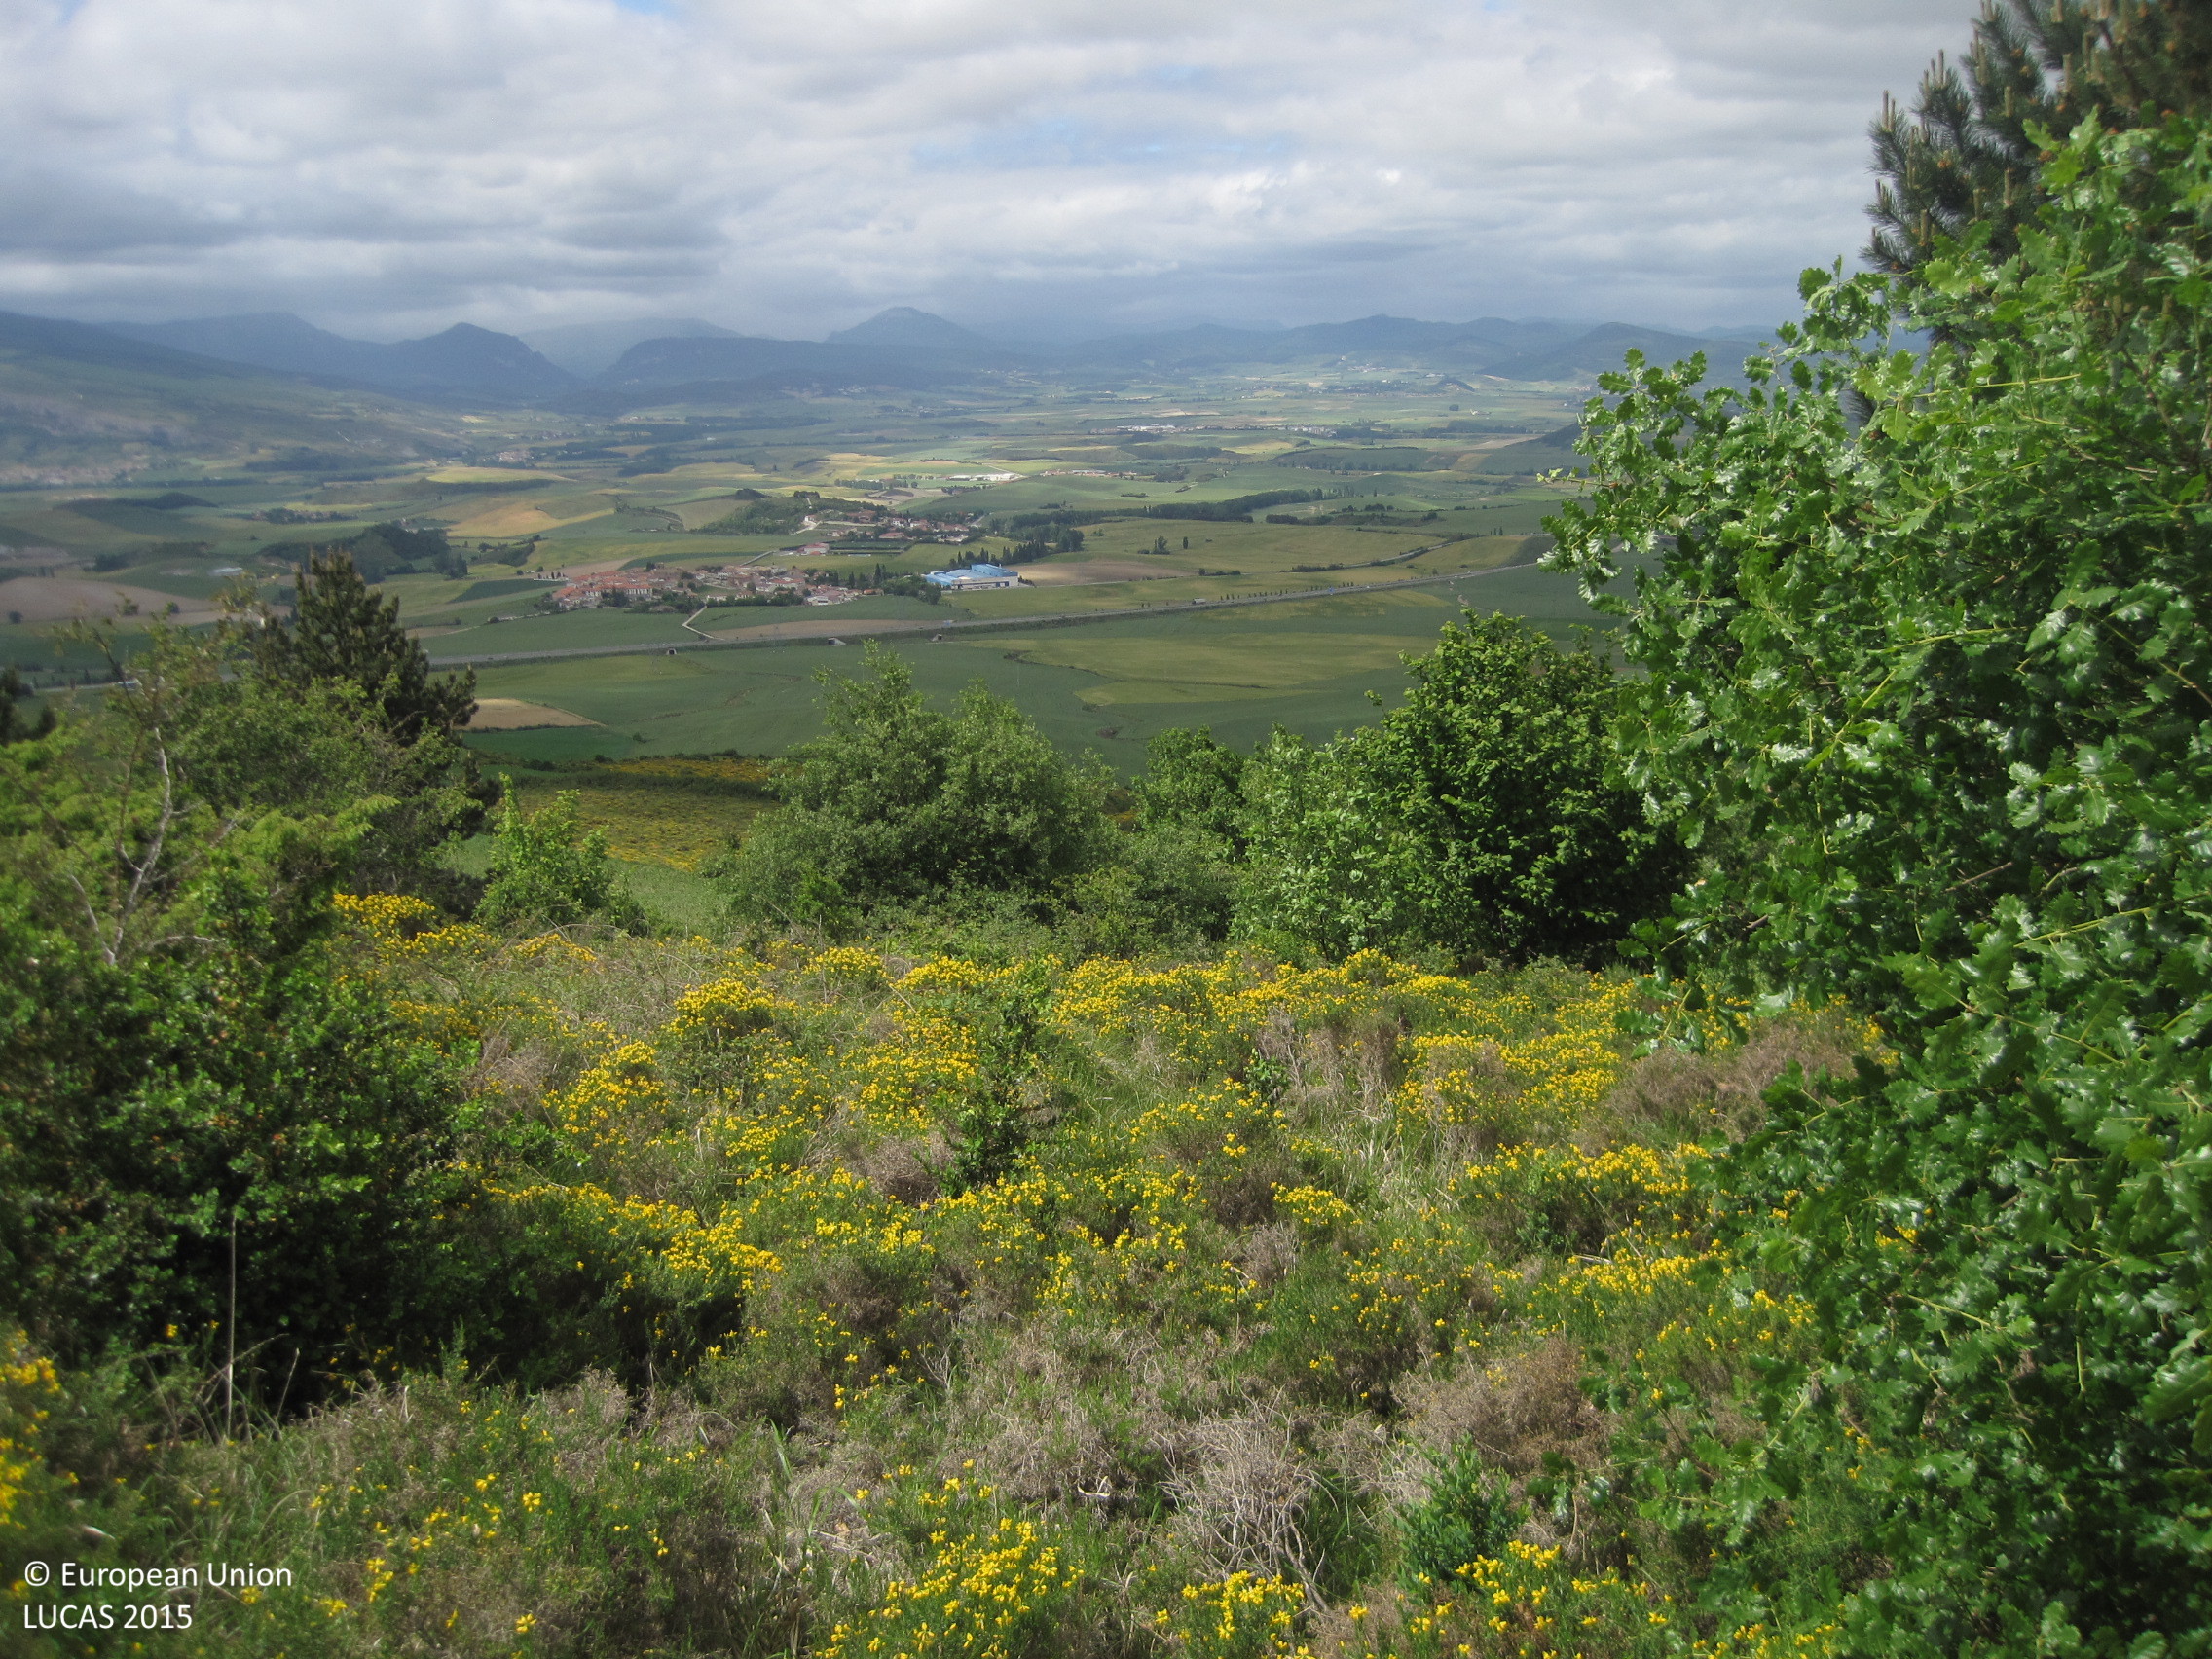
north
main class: Woodland
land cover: Broadleaved woodland
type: acidophilous oak and oak-birch forest
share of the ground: > 75 %
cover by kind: broadleaved forest trees 100 %
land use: Semi-natural and natural areas not in use
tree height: > 5 m
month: May
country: ES
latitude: 42.7357
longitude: -1.7285
